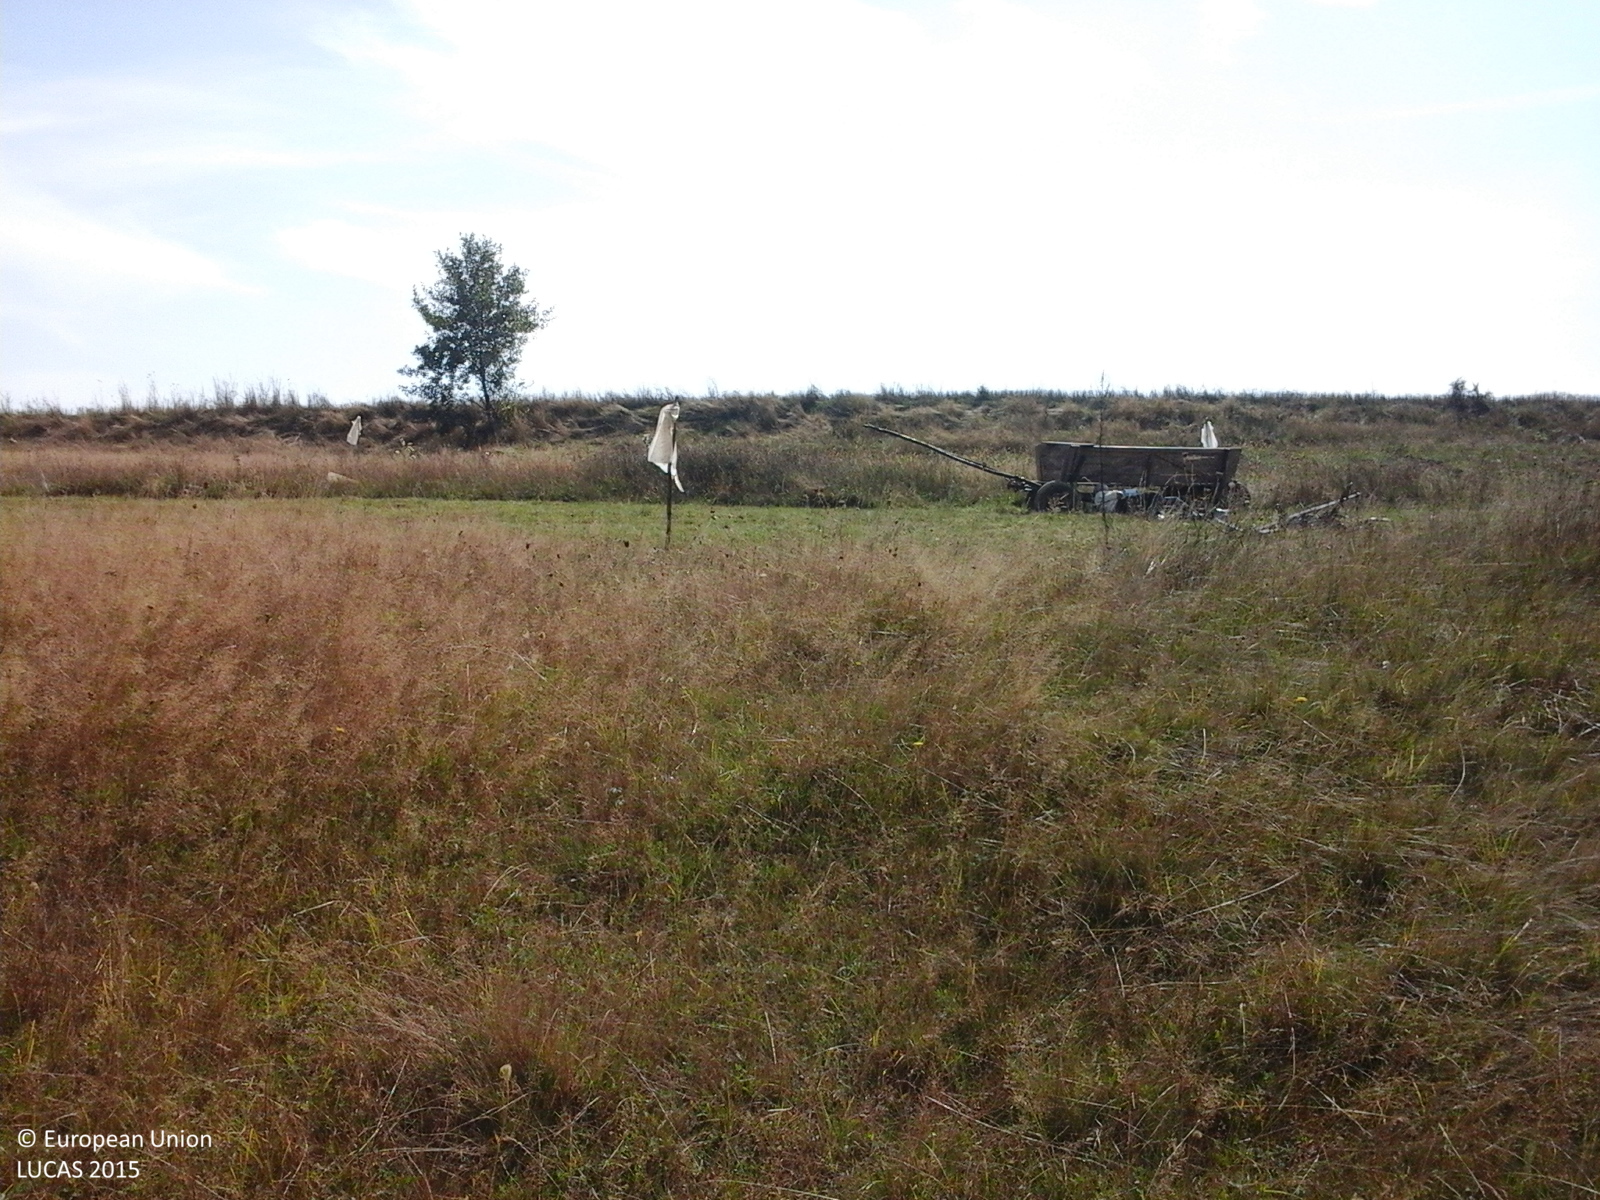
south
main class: Grassland
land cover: Grassland without tree/shrub cover
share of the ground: > 75 %
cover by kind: herbaceous plants 100 %
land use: Agriculture (excluding fallow land and kitchen gardens)
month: September
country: RO
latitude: 46.9279
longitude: 22.9449
